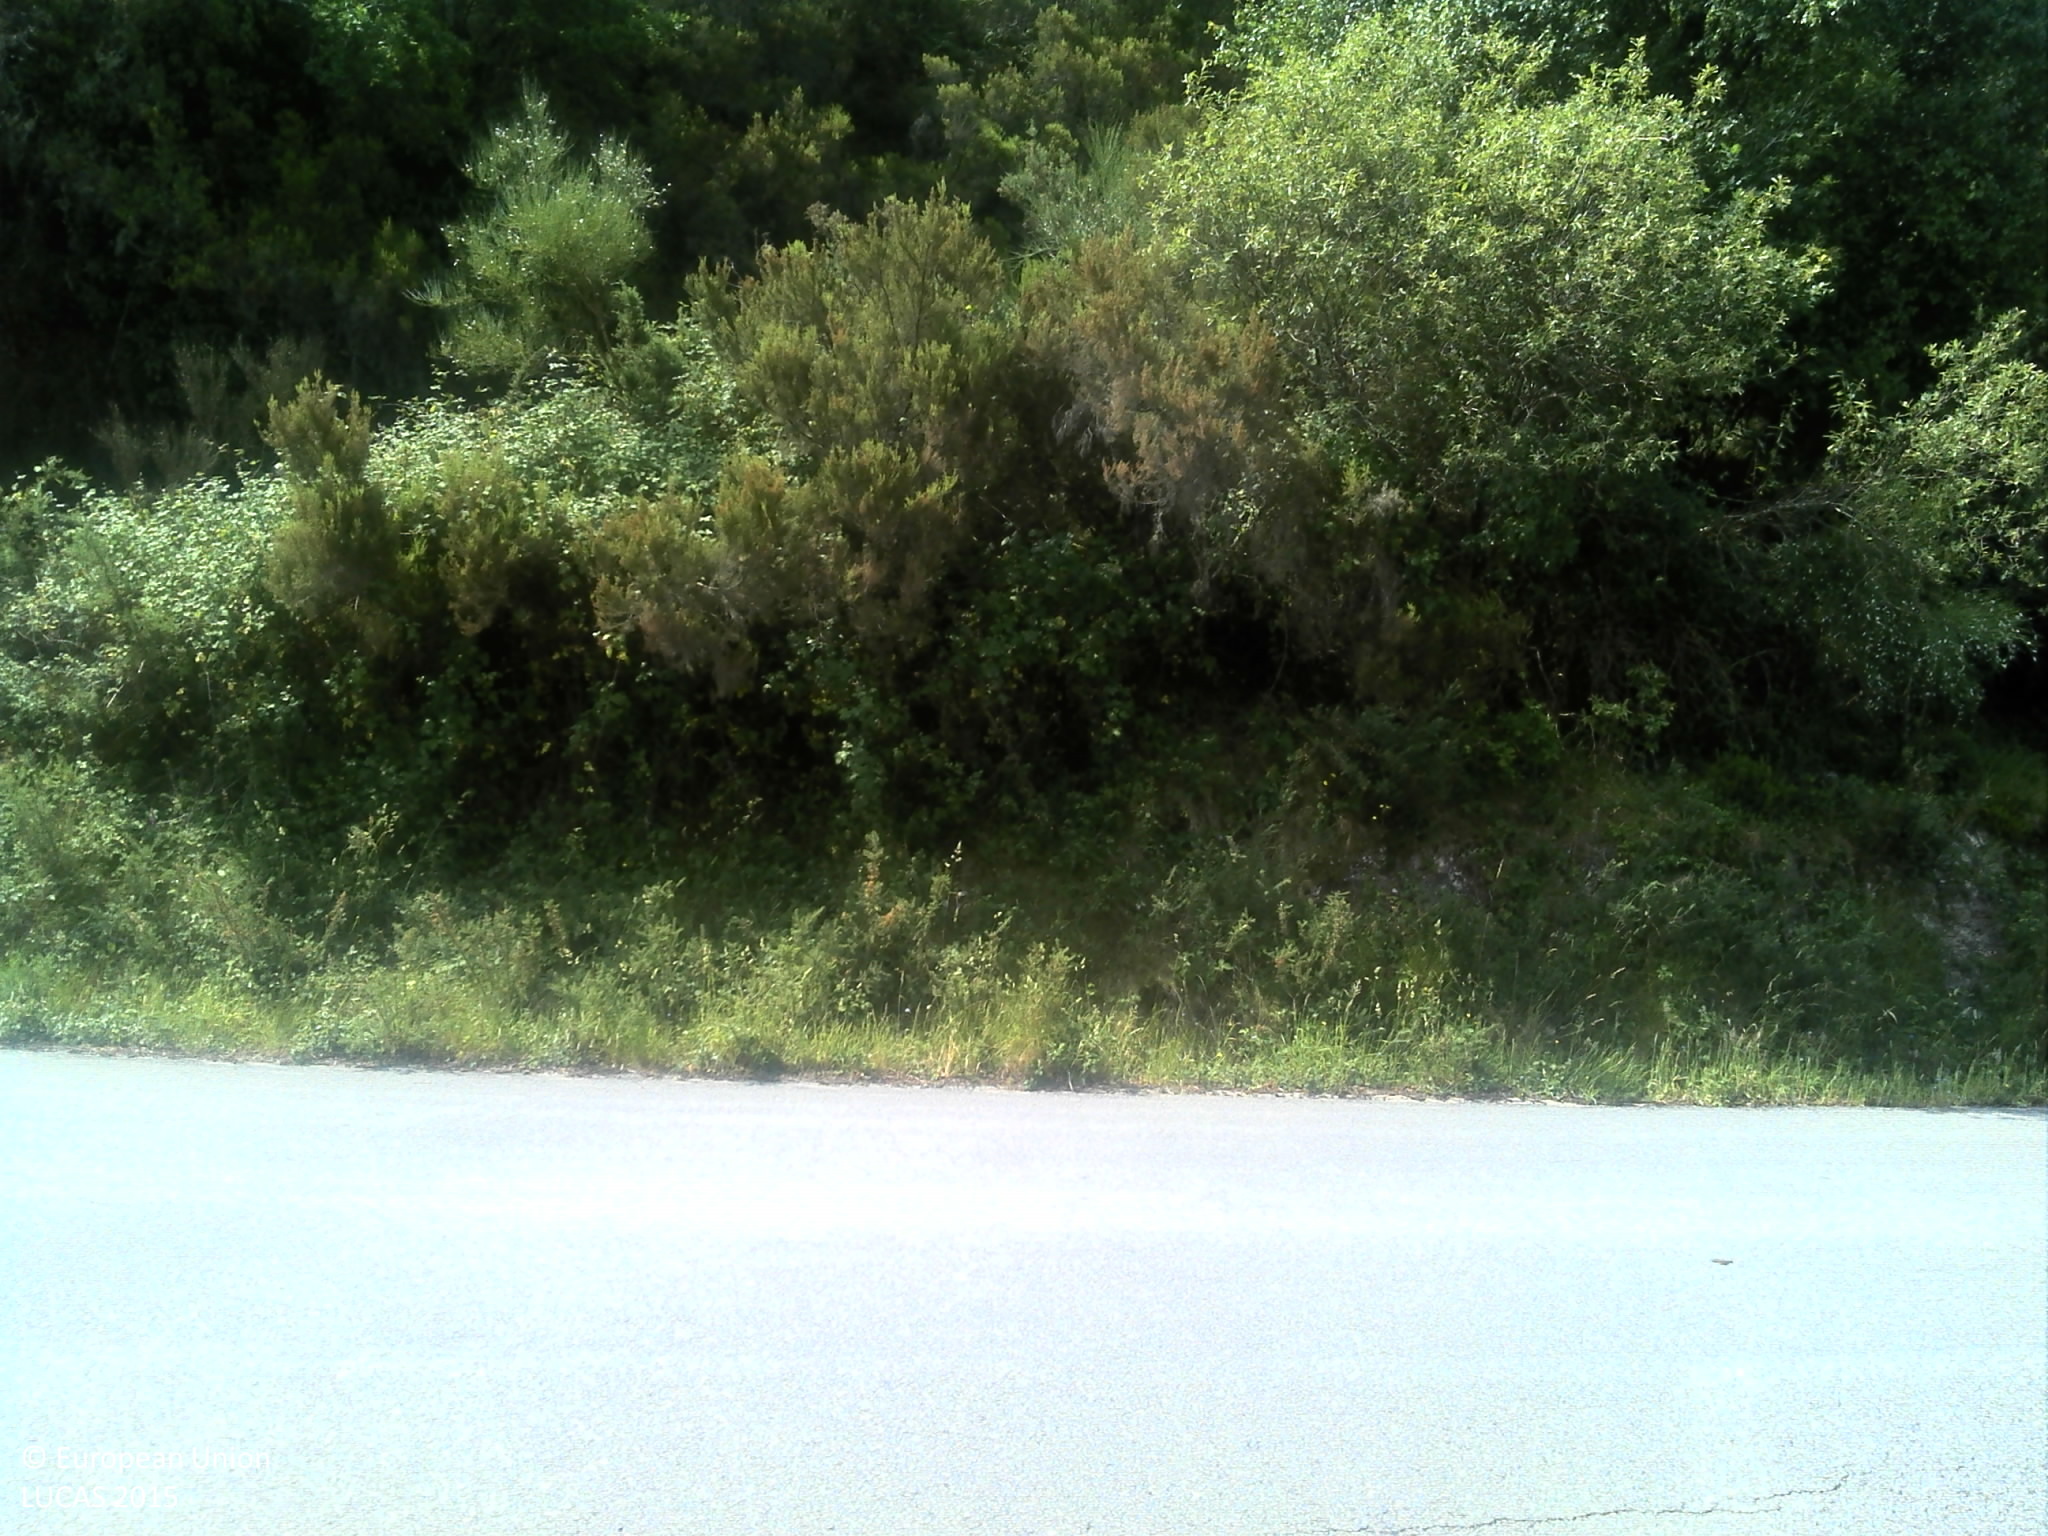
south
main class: Woodland
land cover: Broadleaved woodland
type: thermophilous deciduous forest
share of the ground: 50 - 75 %
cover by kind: broadleaved forest trees 65 %, shrubs 25 %, herbaceous plants 5 %, unconsolidated bare surface 5 %
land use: Semi-natural and natural areas not in use
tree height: > 5 m
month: June
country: PT
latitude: 41.7632
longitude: -8.2053
